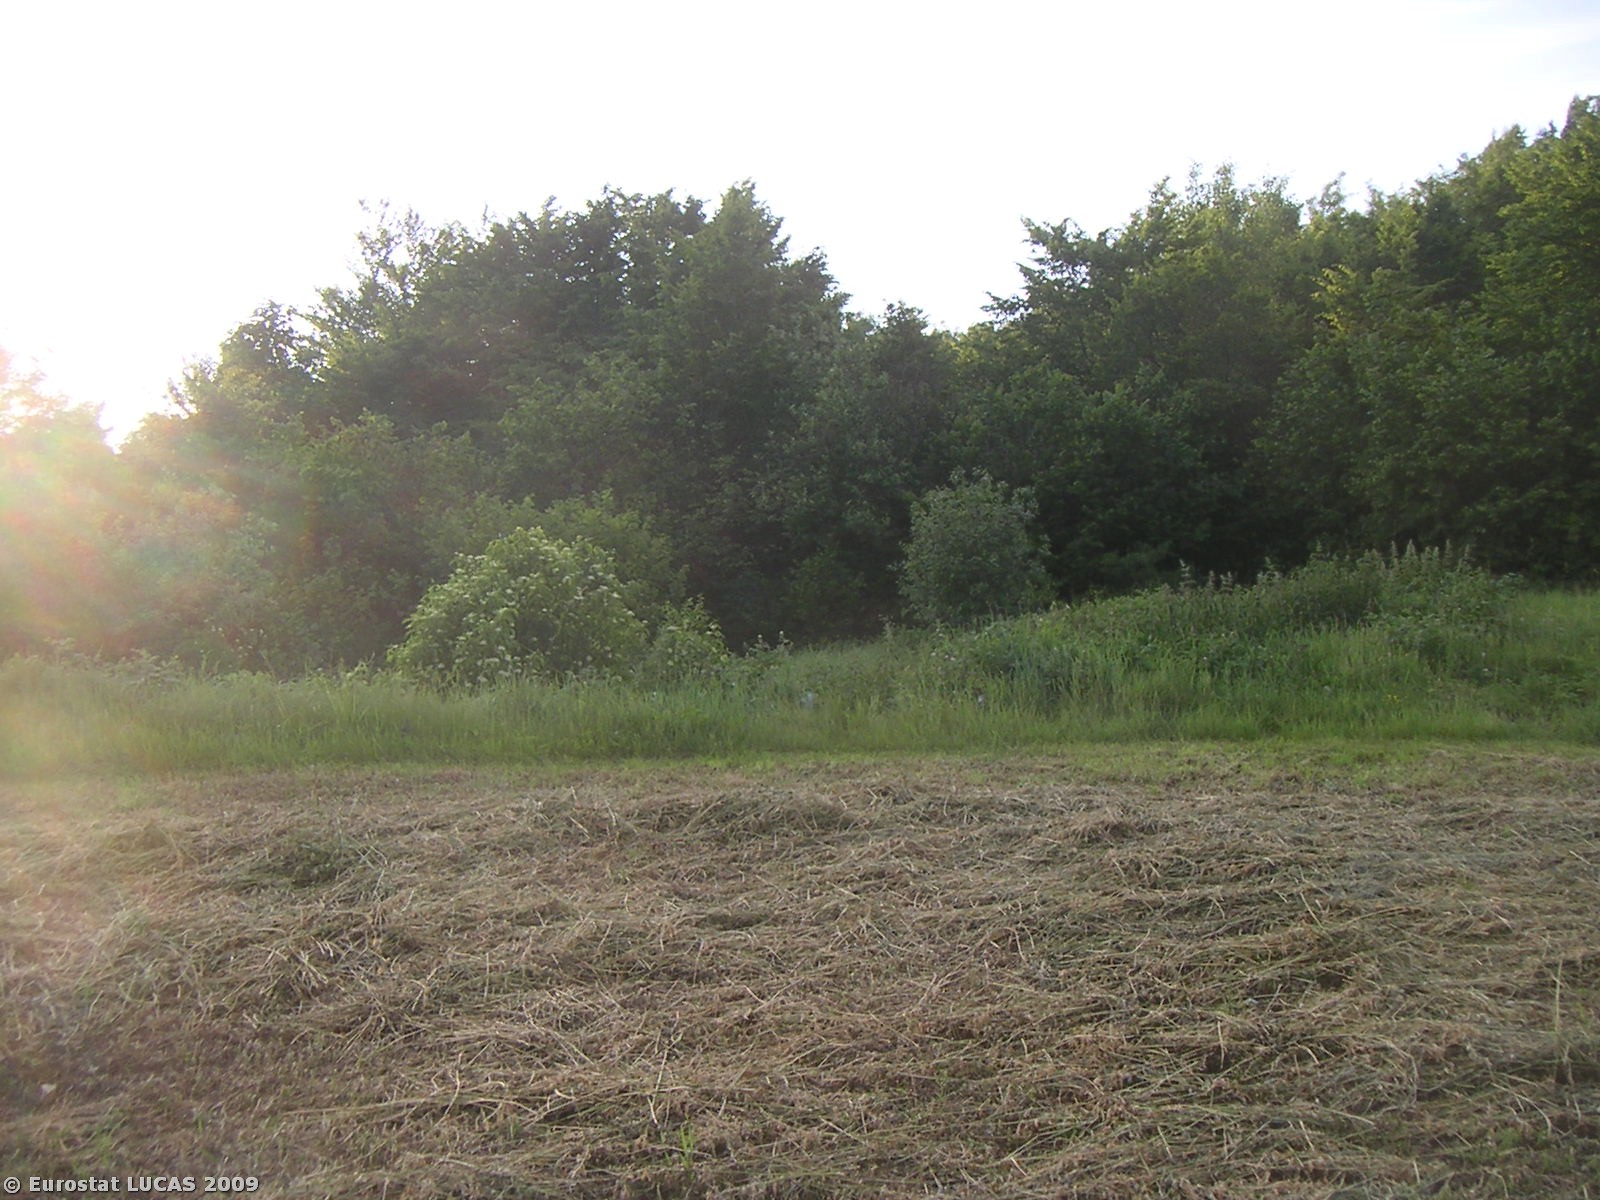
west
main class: Grassland
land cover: Grassland without tree/shrub cover
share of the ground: 50 - 75 %
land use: Agriculture (excluding fallow land and kitchen gardens)
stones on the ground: 25 - 50 %
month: June
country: PL
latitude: 50.3127
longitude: 19.7049
